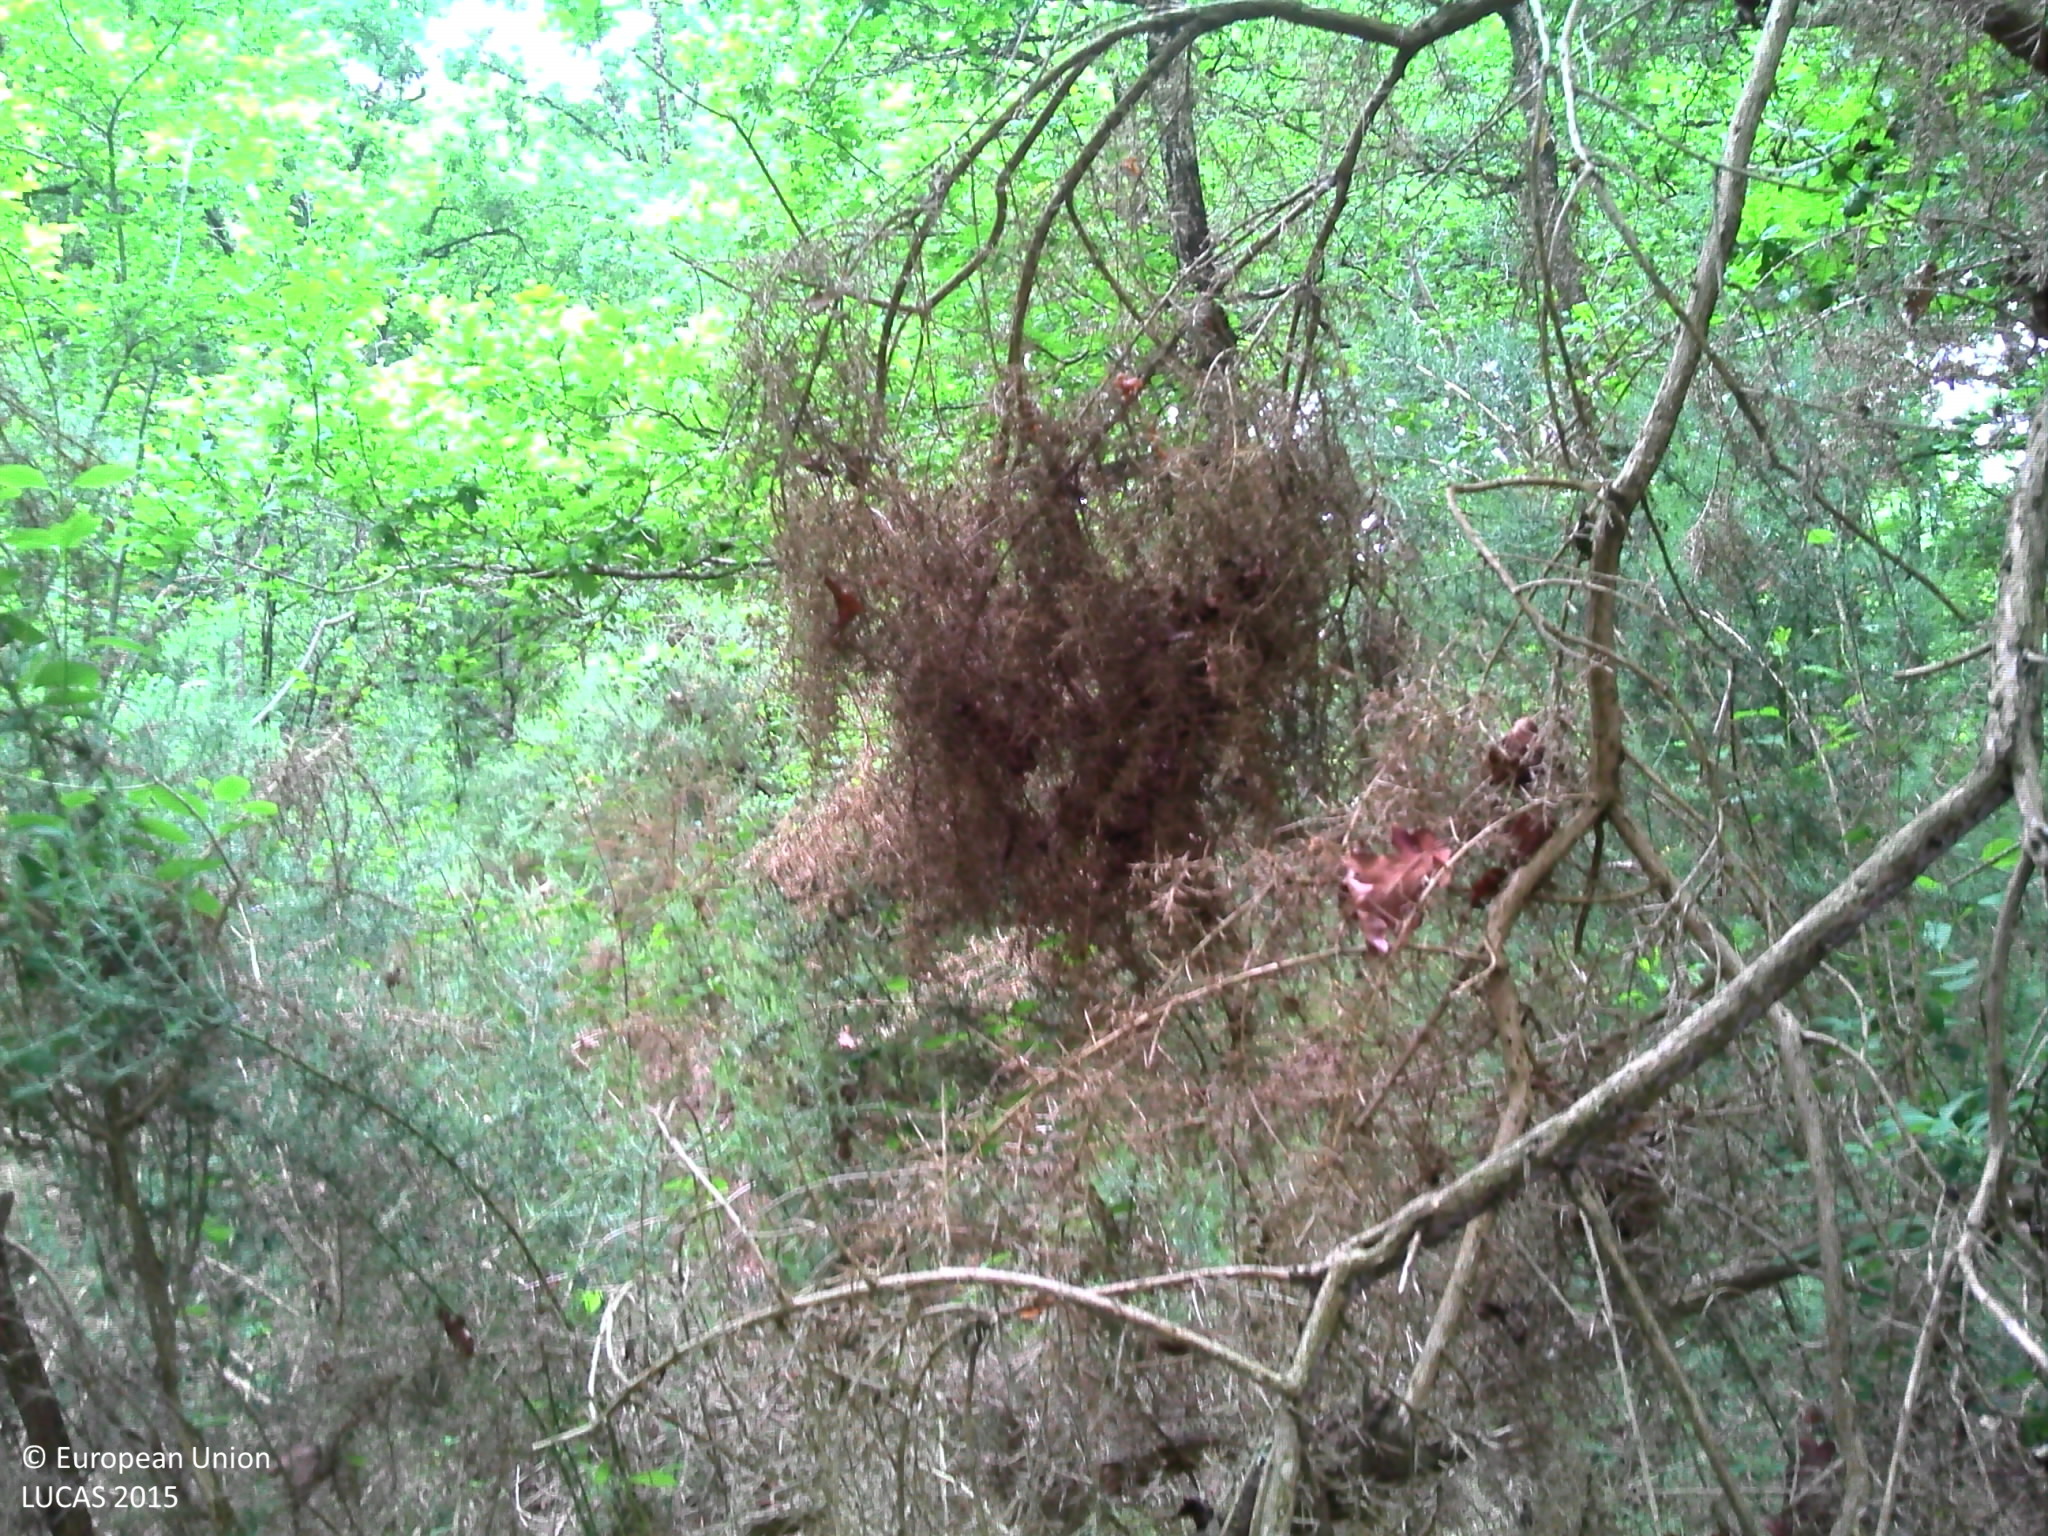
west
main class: Woodland
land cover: Broadleaved woodland
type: acidophilous oak and oak-birch forest
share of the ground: > 75 %
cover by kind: broadleaved forest trees 80 %, unconsolidated bare surface 10 %, shrubs 5 %, herbaceous plants 5 %
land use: Forestry
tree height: > 5 m
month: May
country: FR
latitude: 47.1043
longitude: 0.0807
